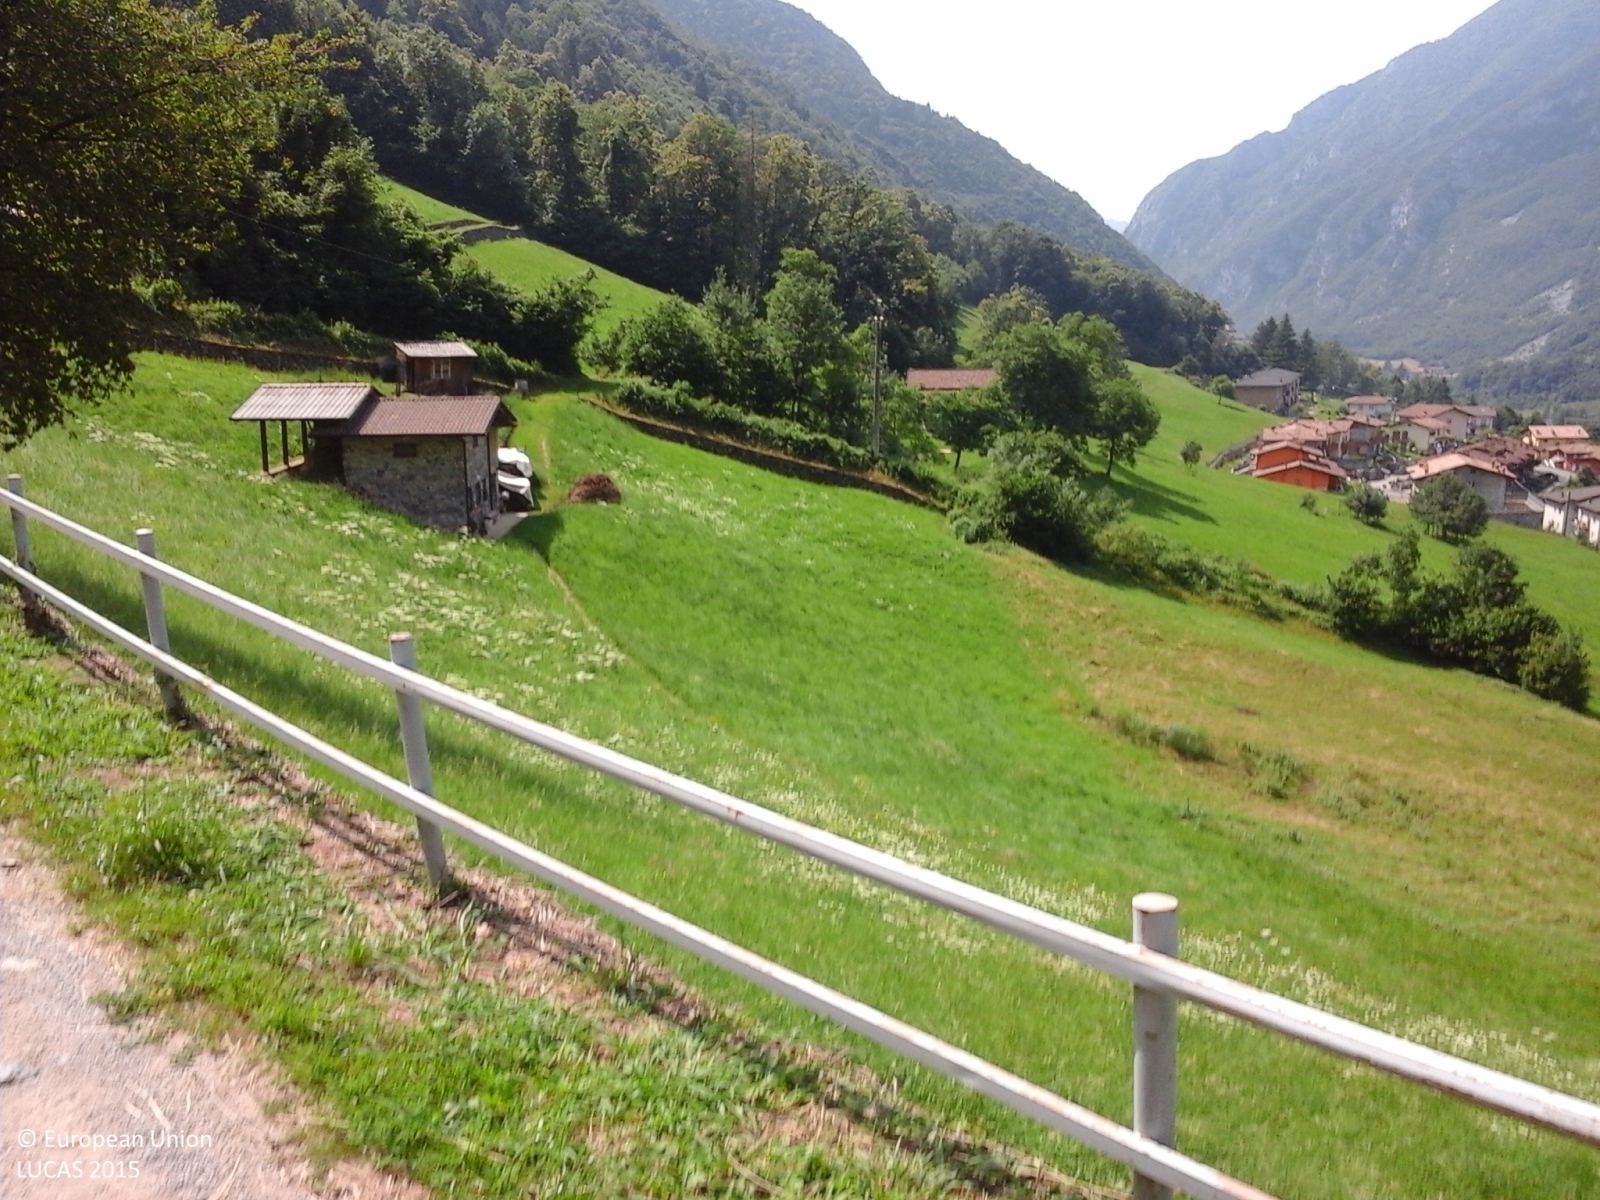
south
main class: Grassland
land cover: Grassland without tree/shrub cover
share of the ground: > 75 %
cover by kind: herbaceous plants 100 %
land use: Agriculture (excluding fallow land and kitchen gardens)
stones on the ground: < 10 %
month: July
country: IT
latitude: 45.9368
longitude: 9.9356
